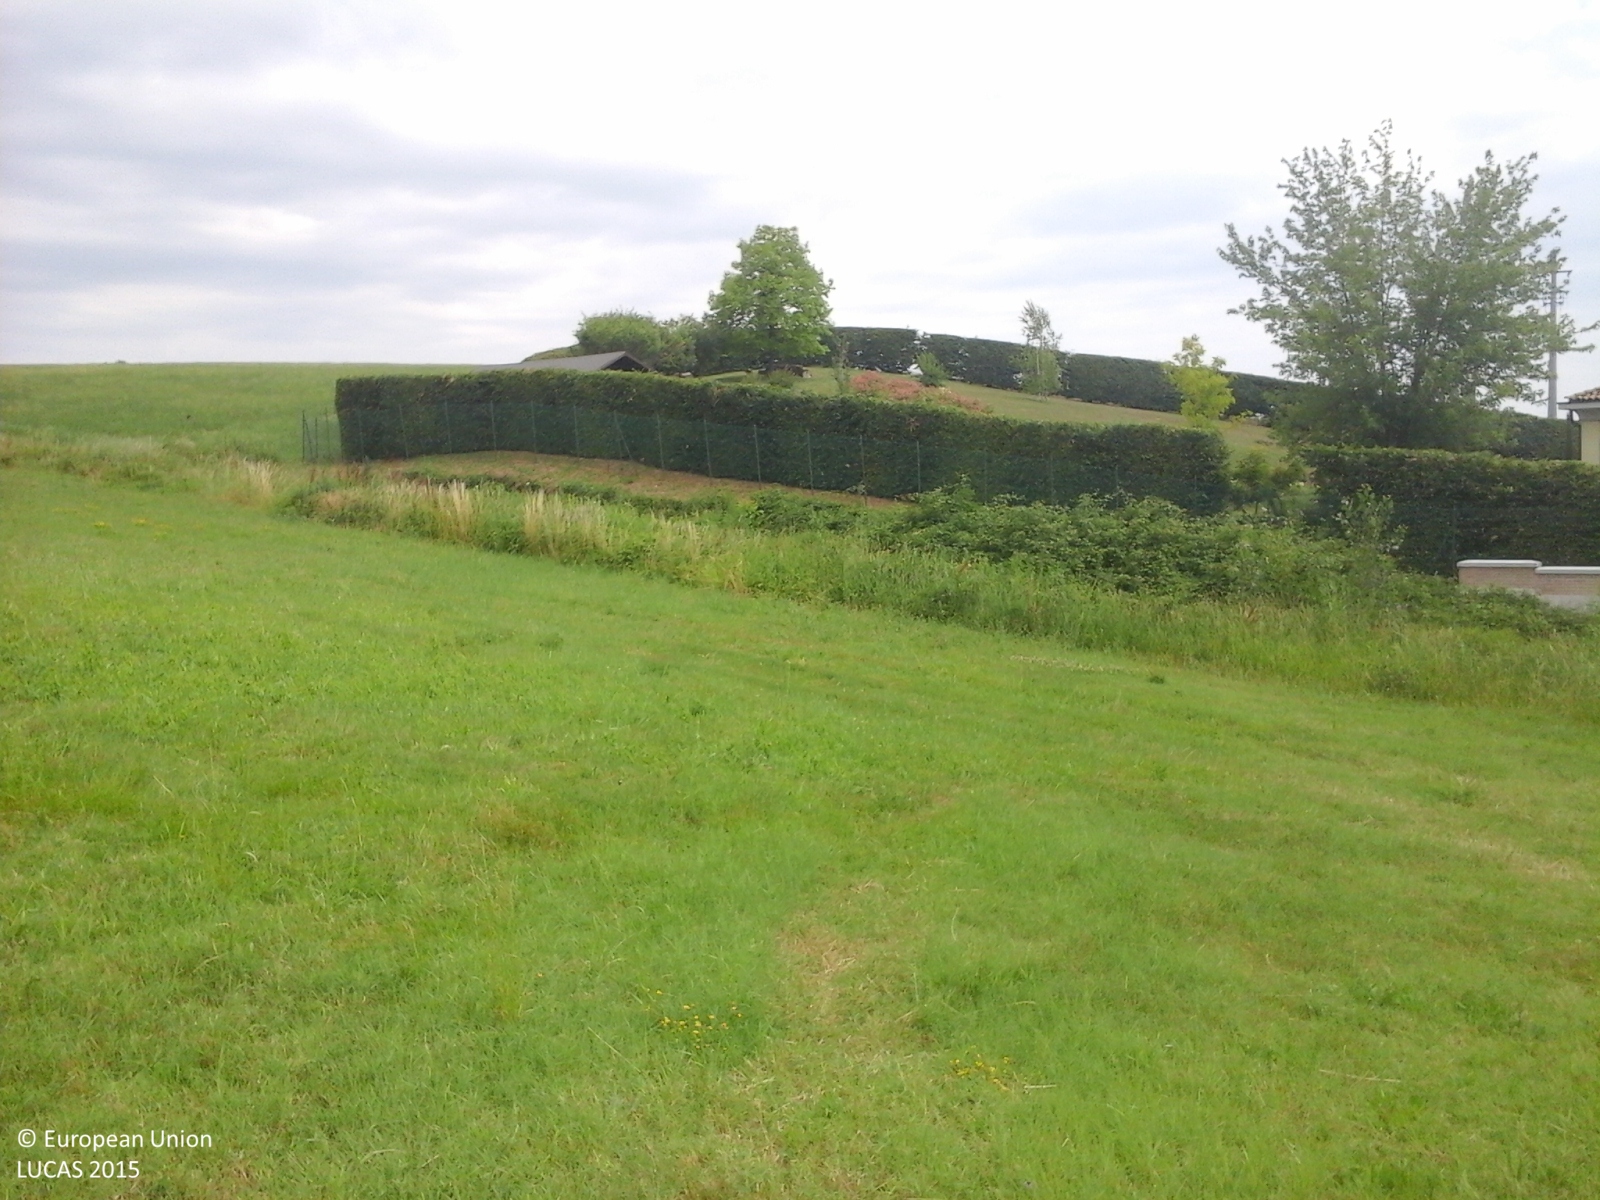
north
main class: Grassland
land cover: Grassland without tree/shrub cover
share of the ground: > 75 %
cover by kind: herbaceous plants 100 %
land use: Agriculture (excluding fallow land and kitchen gardens)
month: June
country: IT
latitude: 44.6207
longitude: 10.2641
